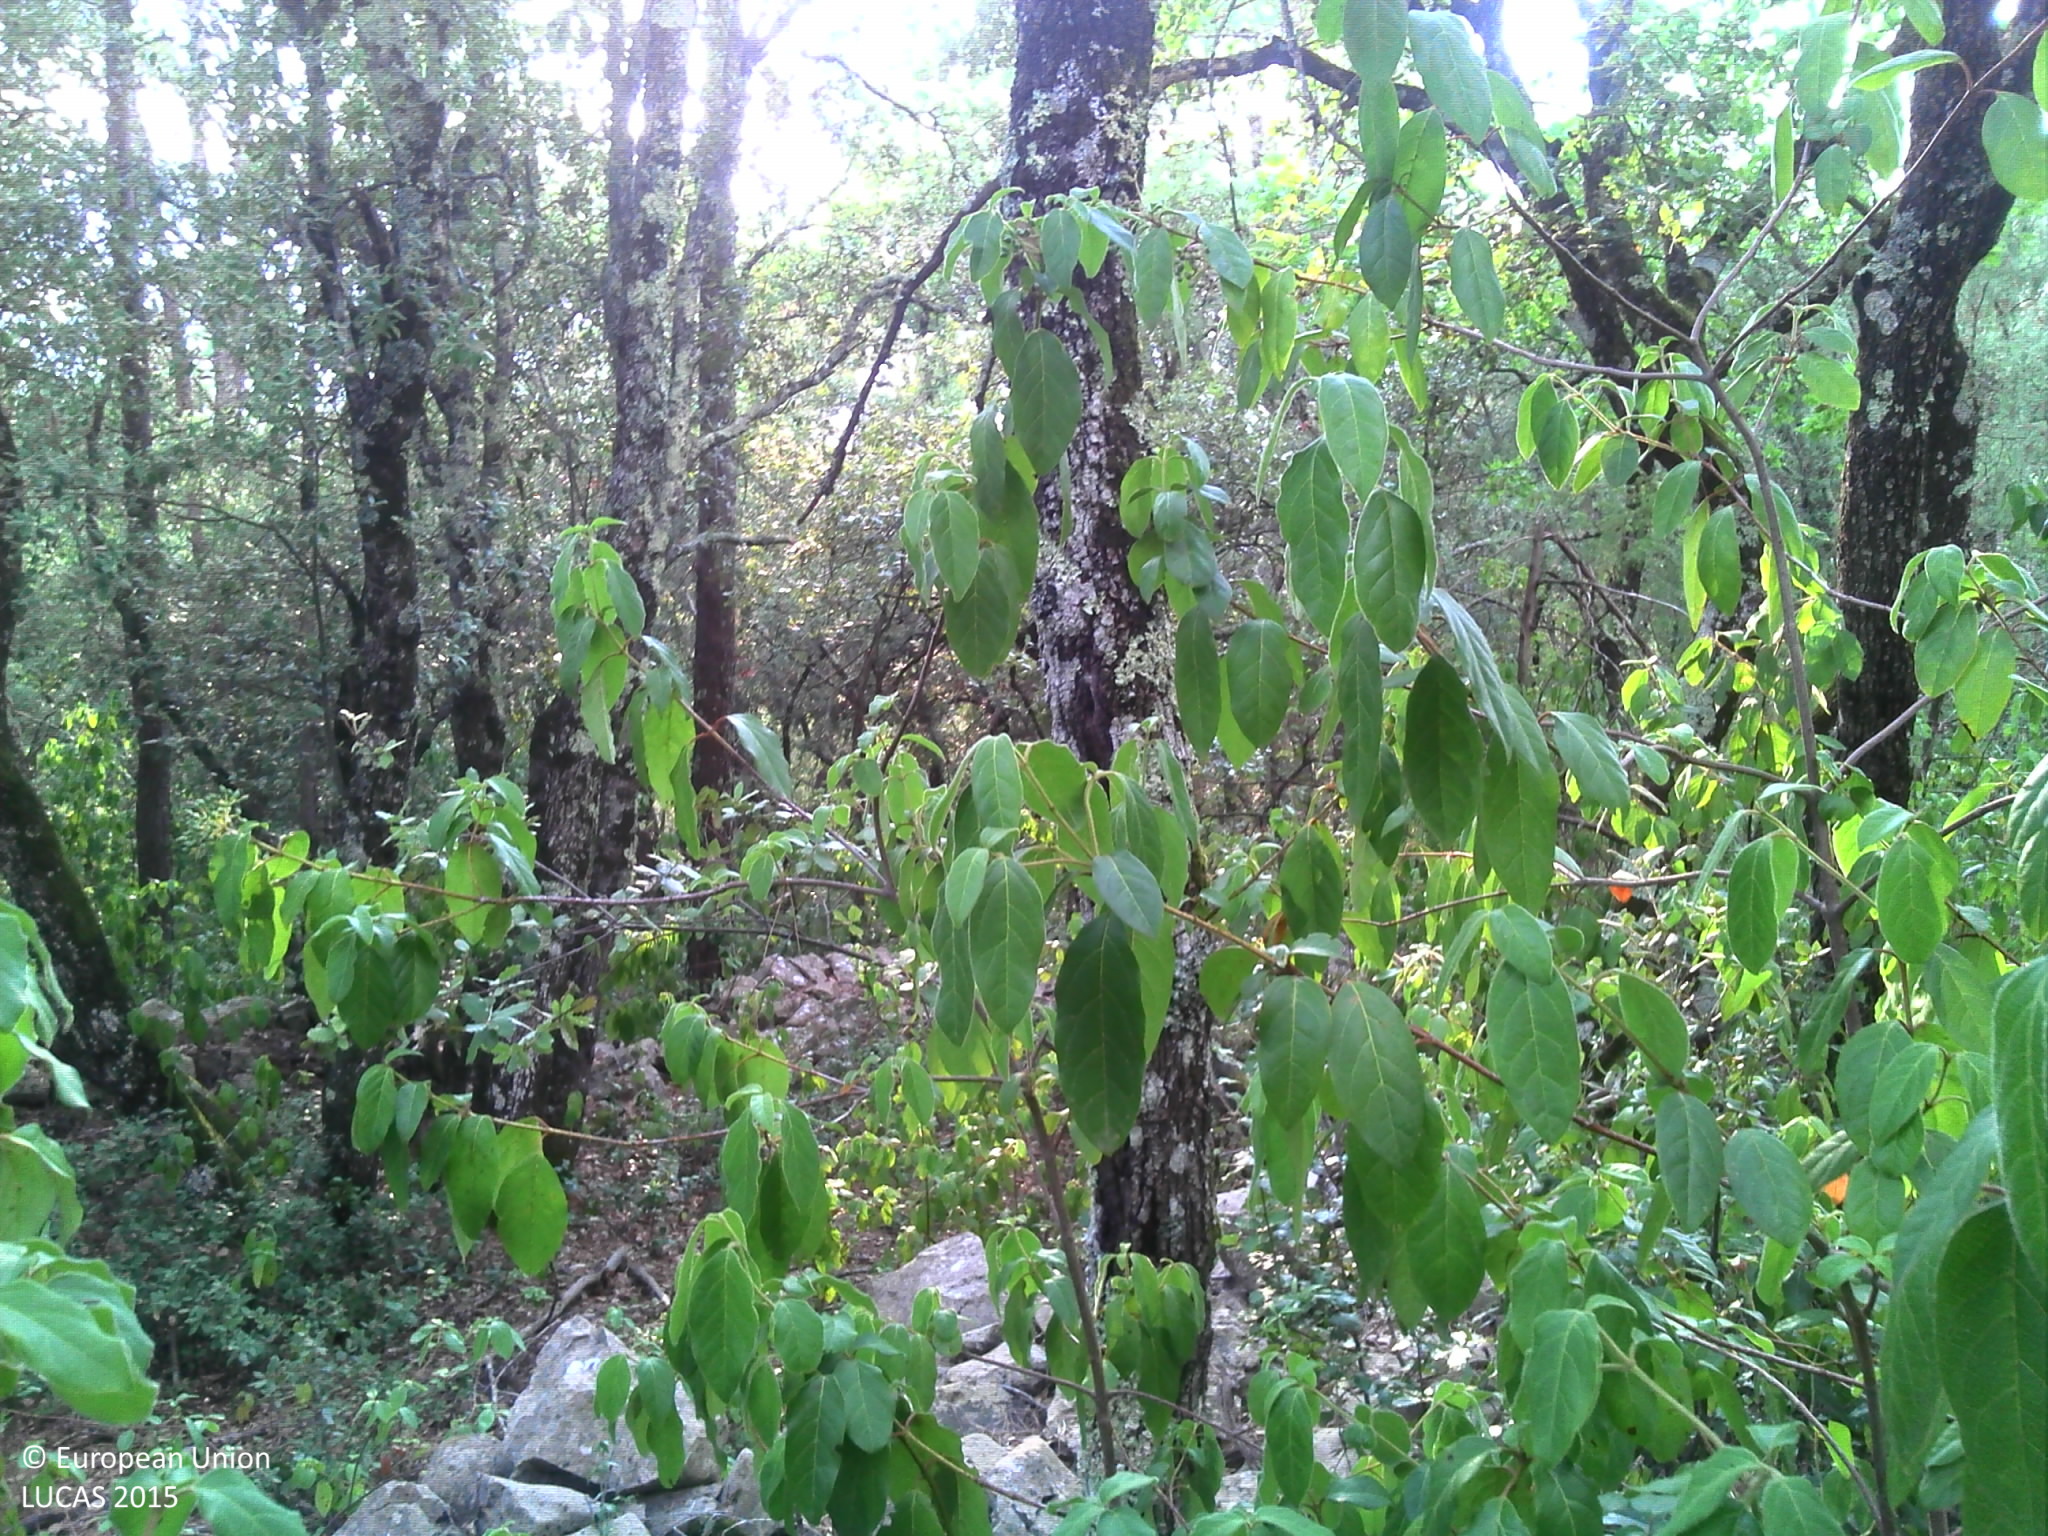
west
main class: Woodland
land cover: Pine dominated mixed woodland
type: coniferous forest of the mediterranean region
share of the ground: > 75 %
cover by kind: broadleaved forest trees 50 %, coniferous forest trees 25 %, shrubs 15 %, unconsolidated bare surface 10 %
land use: Semi-natural and natural areas not in use
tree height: > 5 m
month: August
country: FR
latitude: 43.5093
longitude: 6.3350
